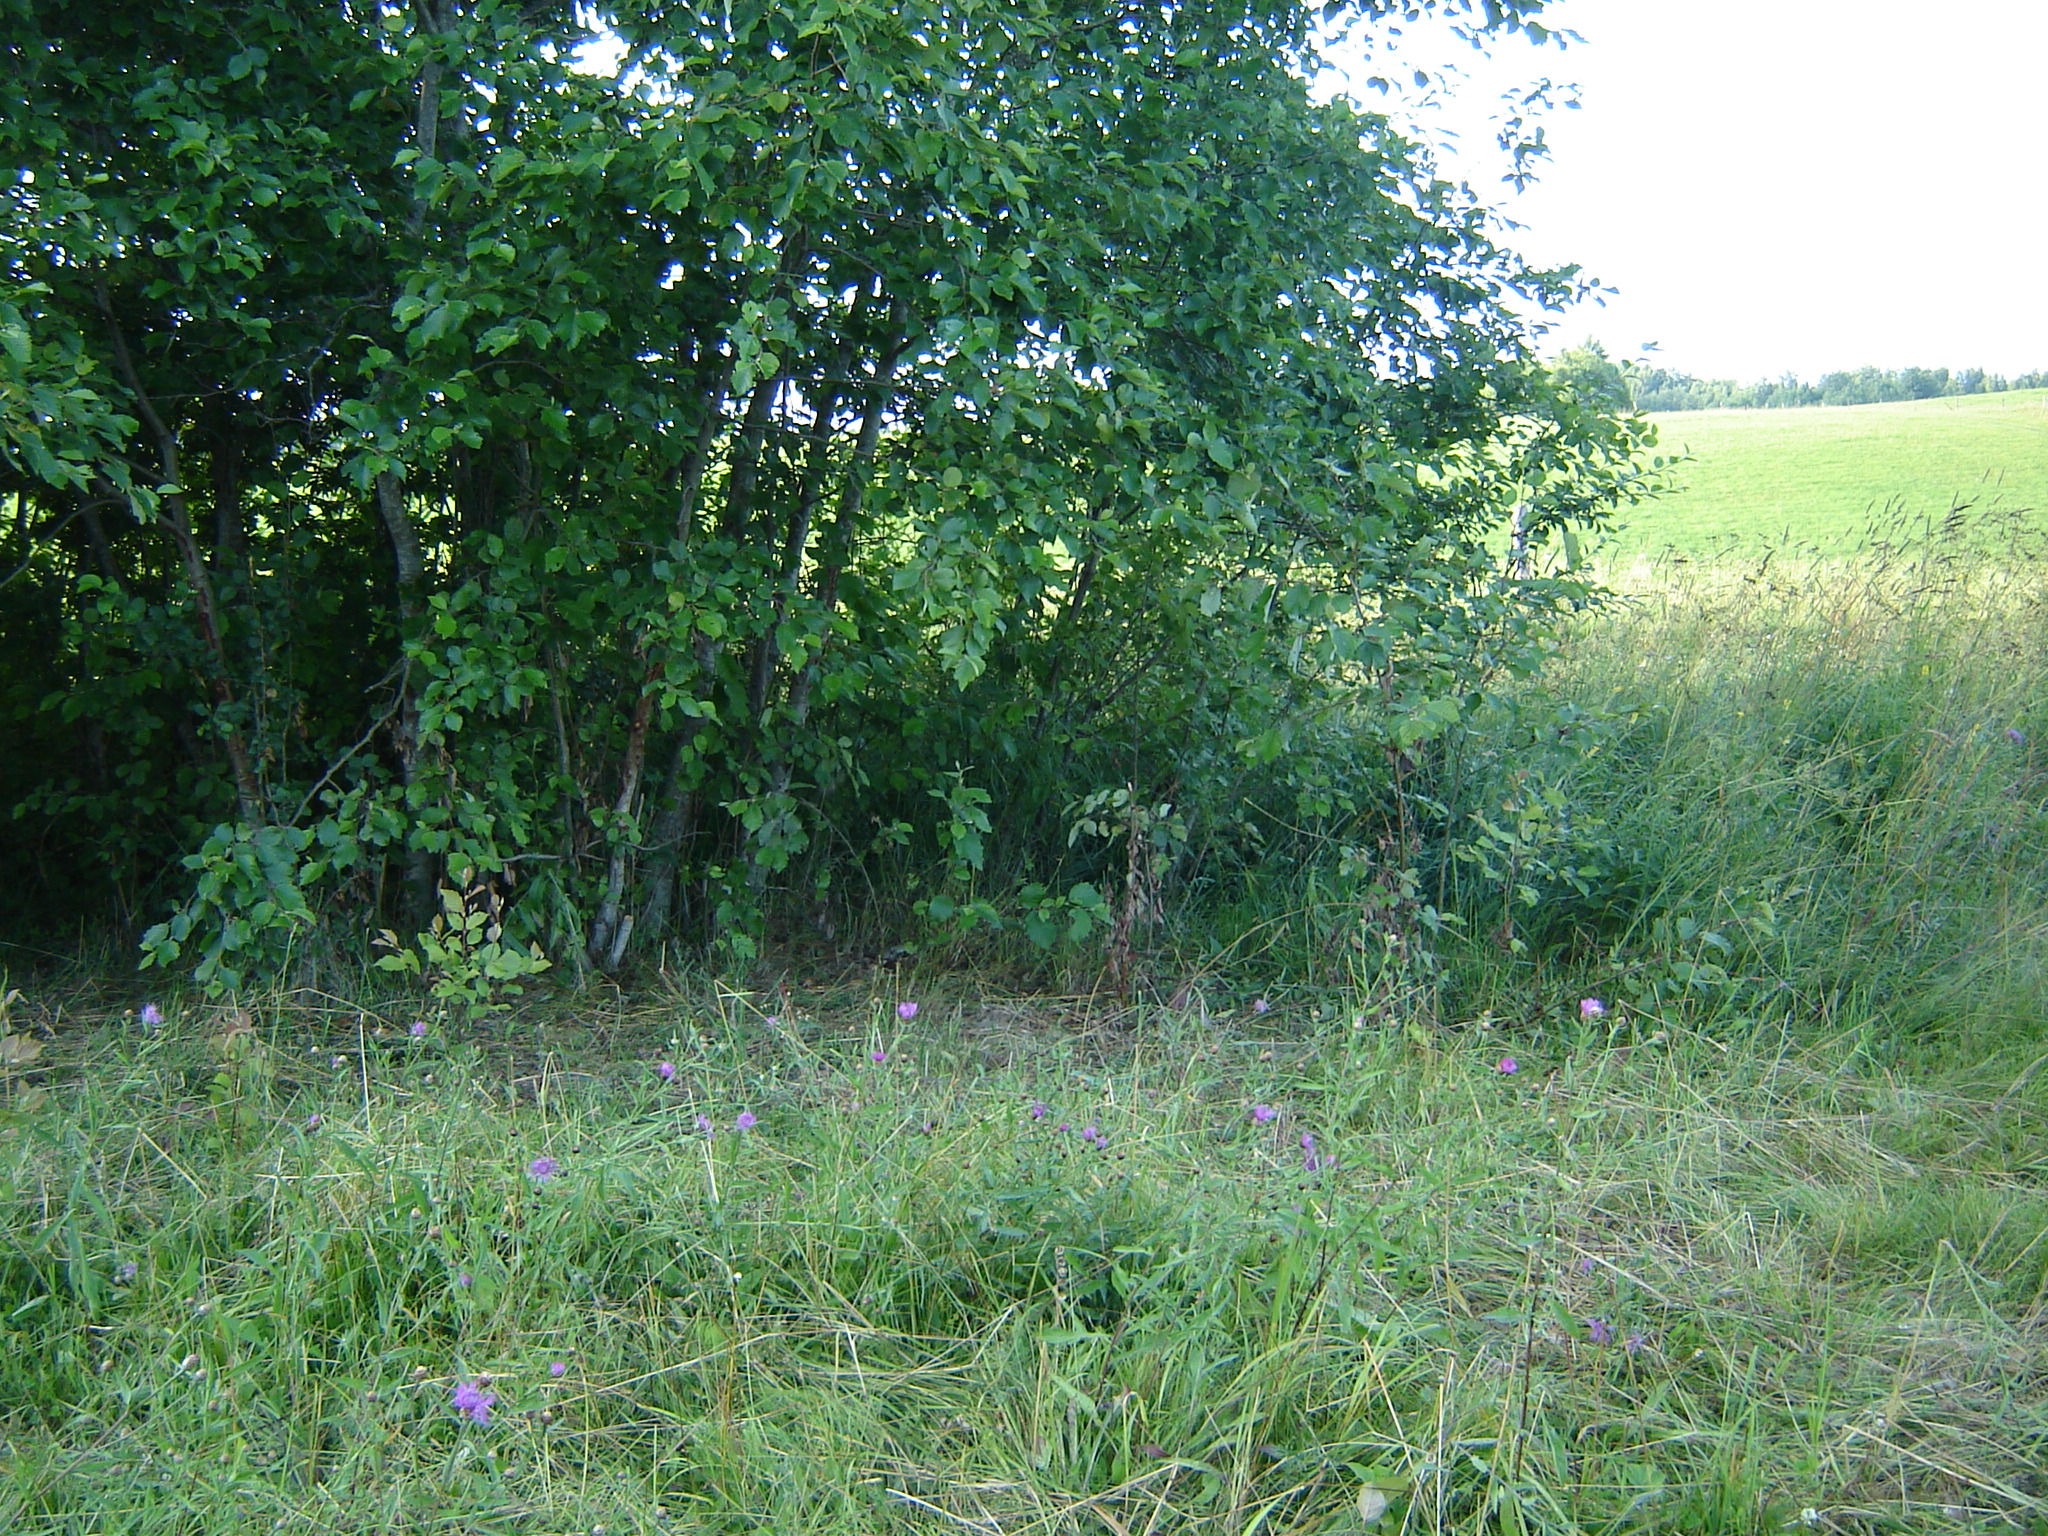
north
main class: Grassland
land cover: Grassland without tree/shrub cover
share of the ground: > 75 %
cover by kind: herbaceous plants 100 %
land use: Agriculture (excluding fallow land and kitchen gardens)
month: July
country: LT
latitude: 55.3901
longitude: 25.4524
